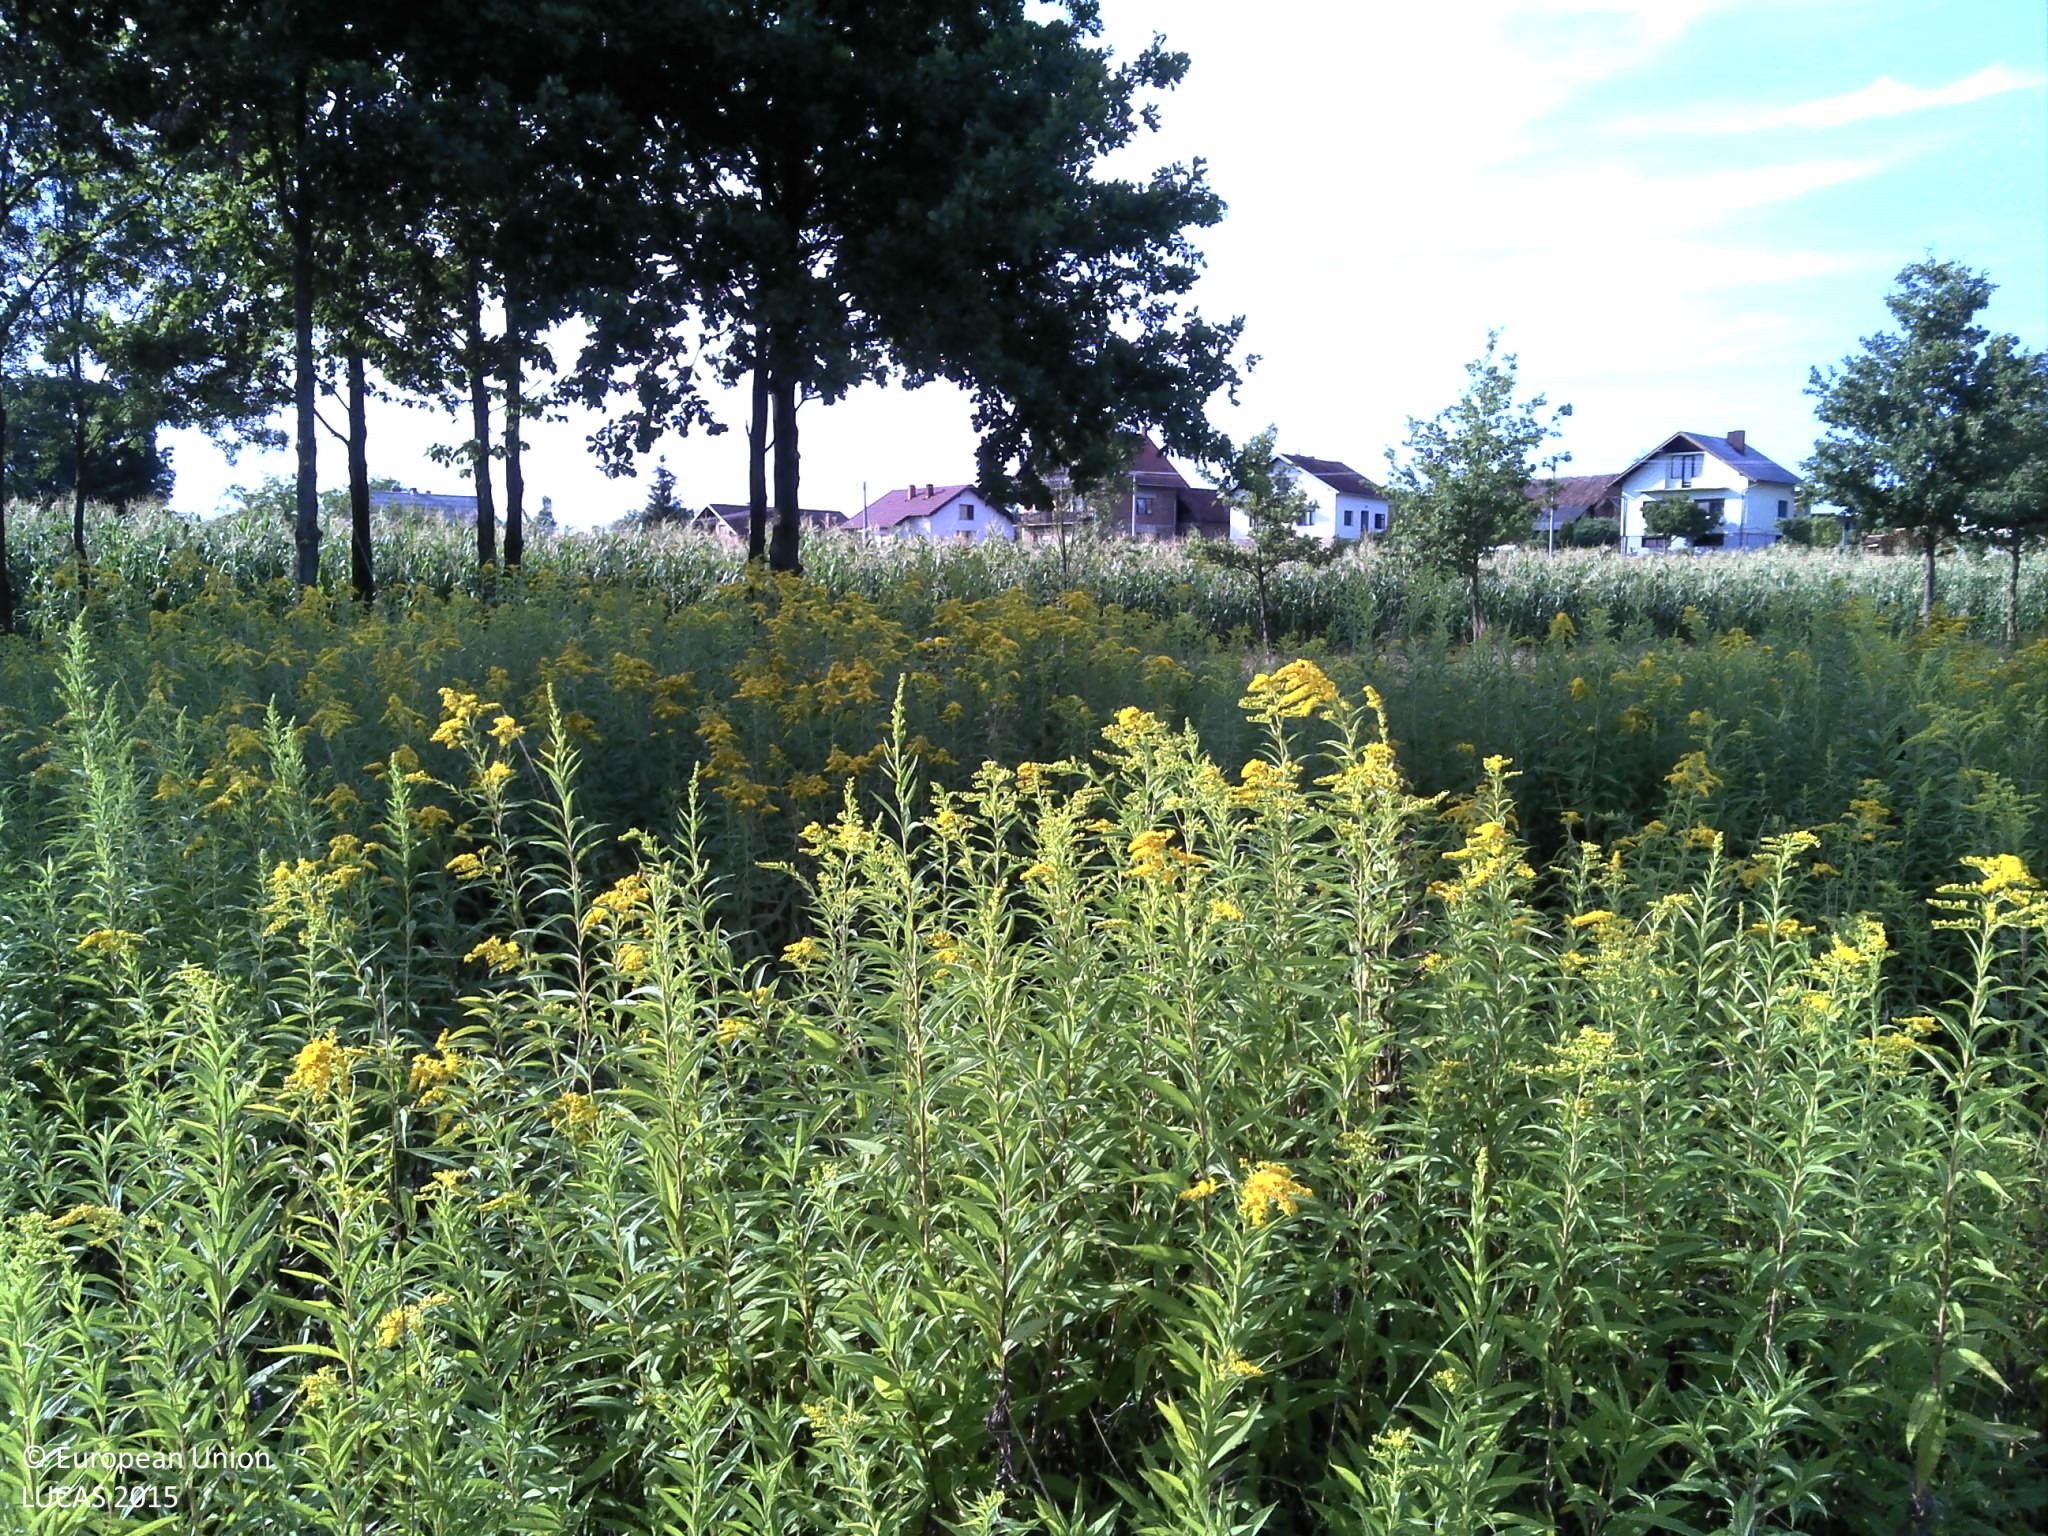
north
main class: Grassland
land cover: Grassland without tree/shrub cover
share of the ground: > 75 %
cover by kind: herbaceous plants 100 %
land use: Agriculture (excluding fallow land and kitchen gardens)
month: July
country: HR
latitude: 45.6066
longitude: 16.5764
